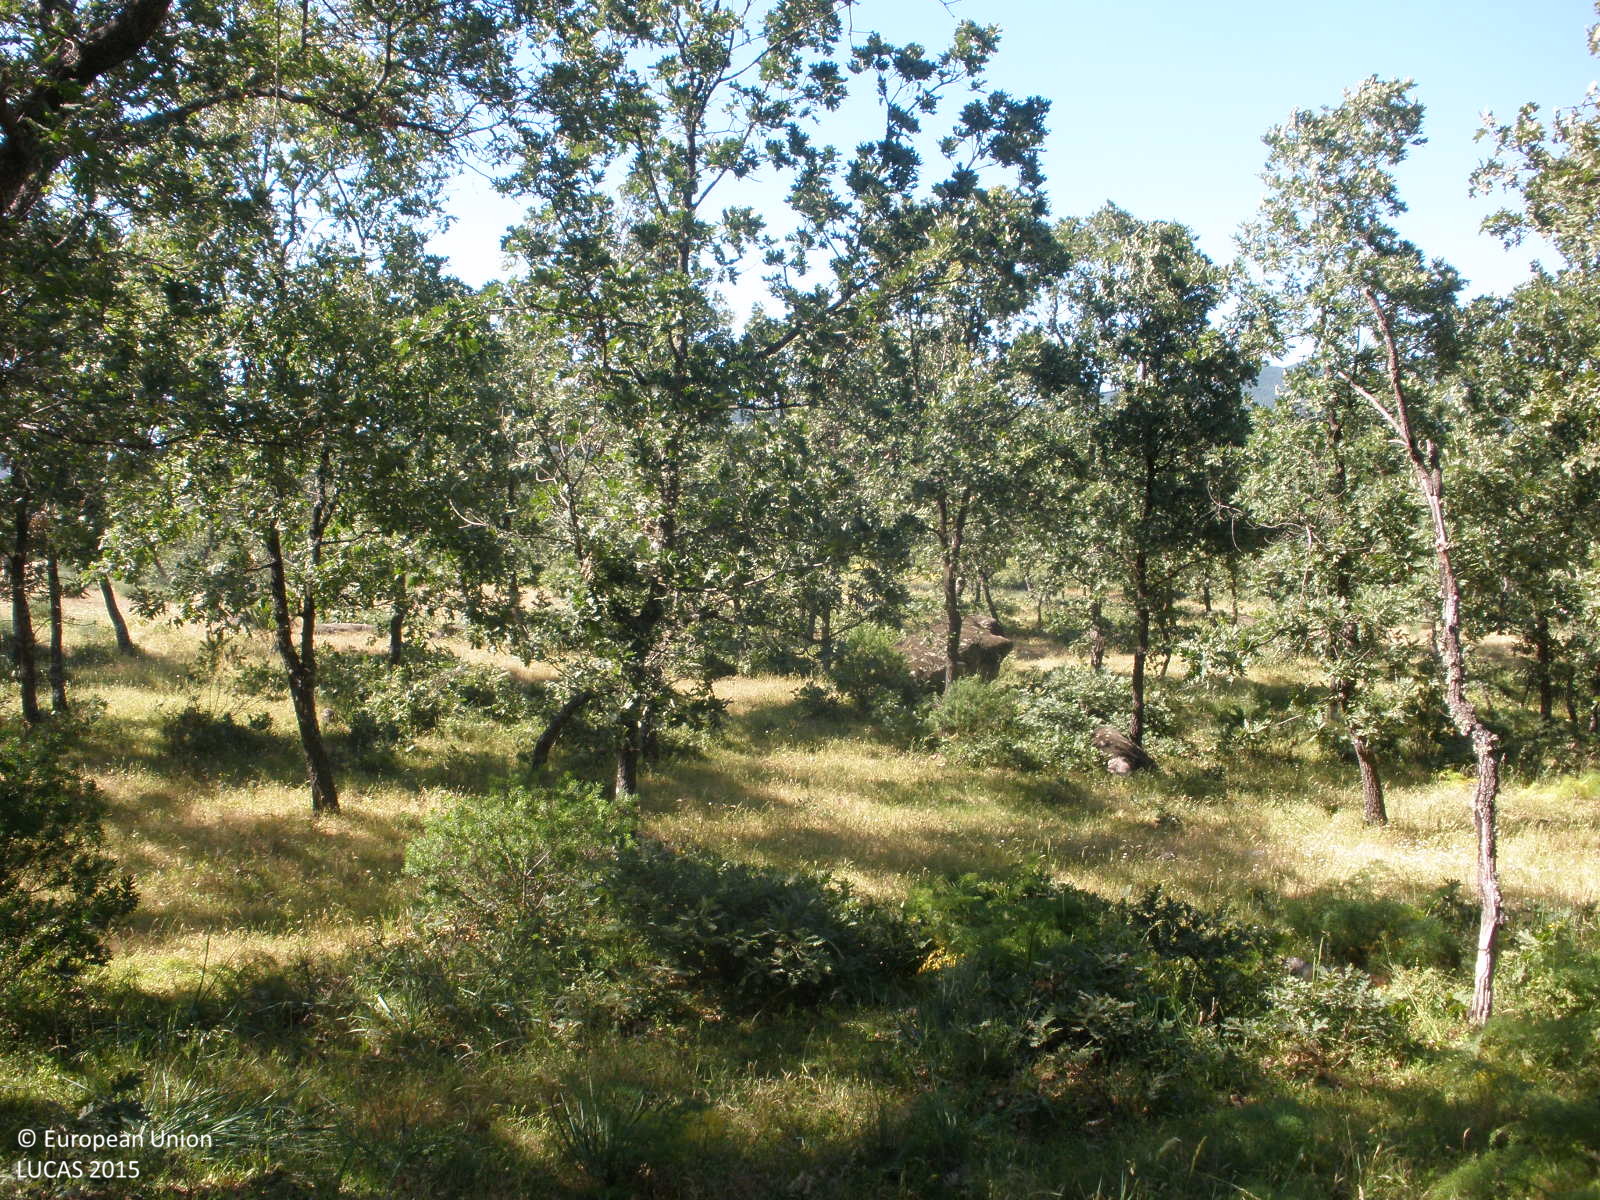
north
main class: Woodland
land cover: Broadleaved woodland
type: broadleaved evergreen forest
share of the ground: > 75 %
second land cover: Grassland without tree/shrub cover
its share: > 75 %
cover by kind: broadleaved forest trees 80 %, herbaceous plants 20 %
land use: Forestry
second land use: Agriculture (excluding fallow land and kitchen gardens)
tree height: > 5 m
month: May
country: ES
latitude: 40.1358
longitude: -6.7891
